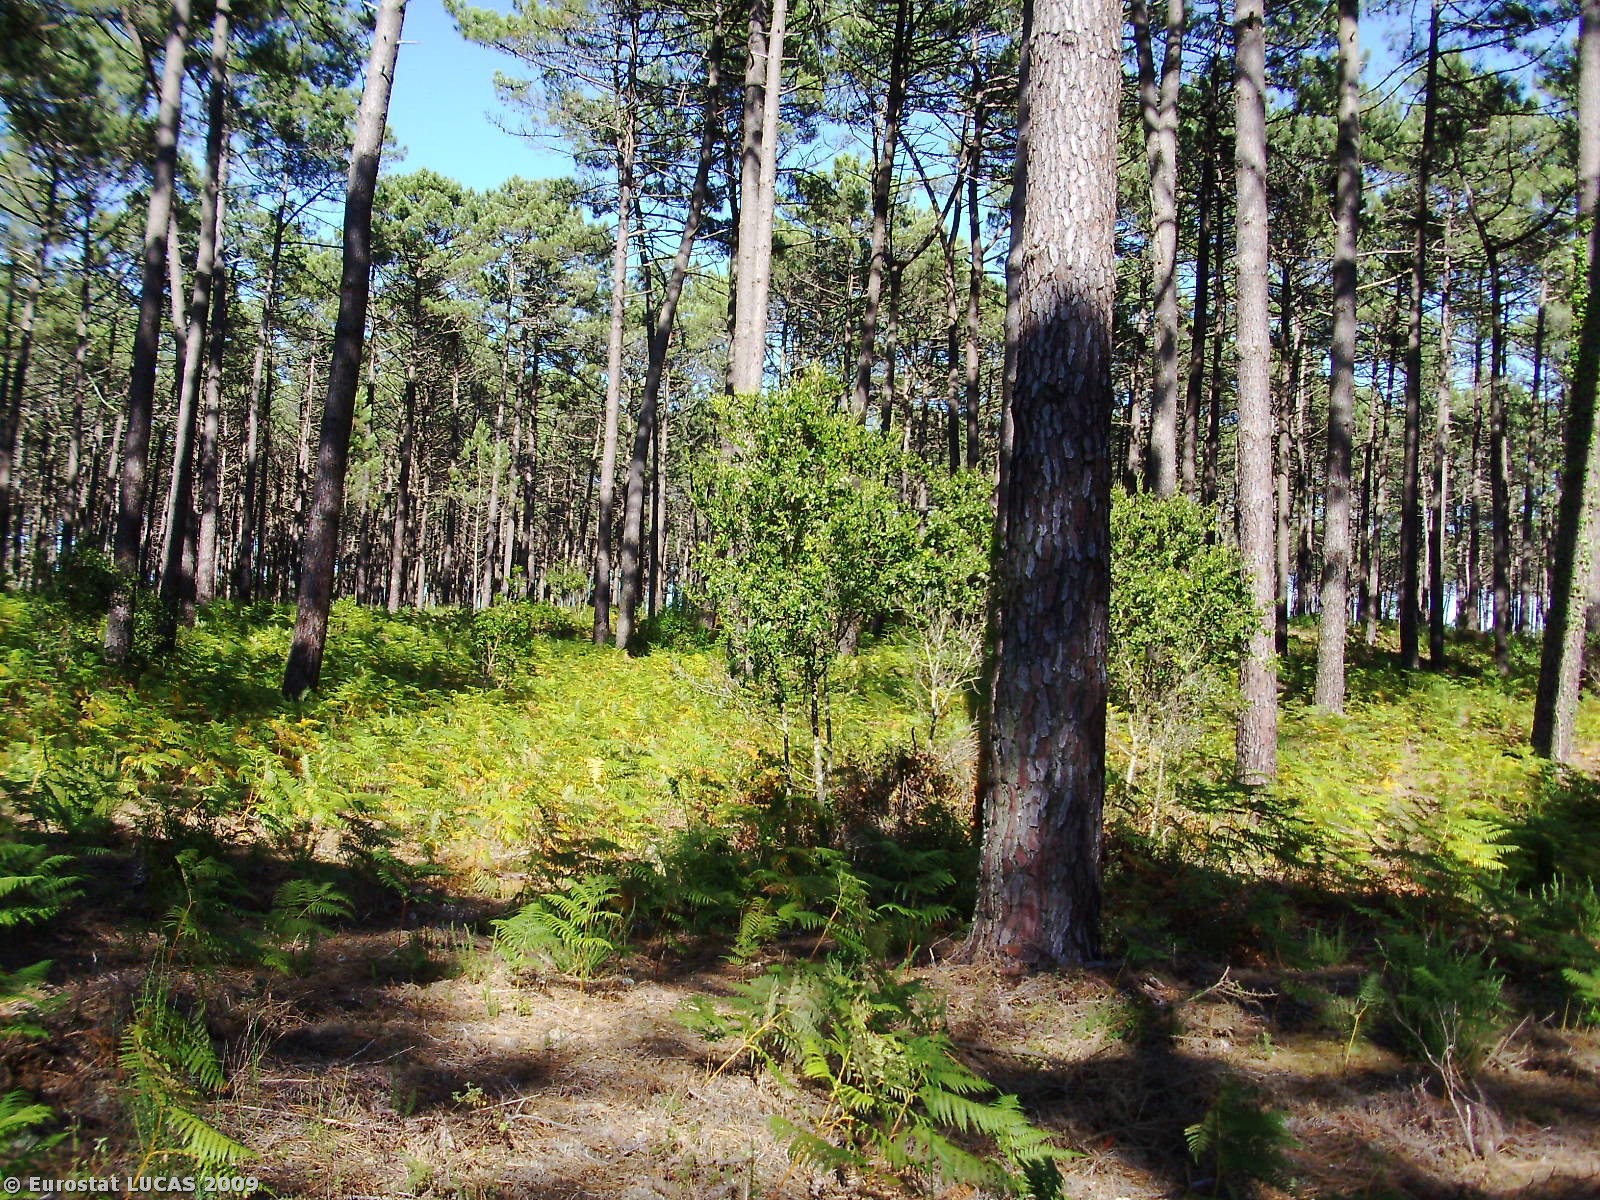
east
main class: Woodland
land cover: Coniferous woodland
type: coniferous forest of the mediterranean region
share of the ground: > 75 %
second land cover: Shrubland with sparse tree cover
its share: 10 - 25 %
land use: Forestry
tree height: > 5 m
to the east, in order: Coniferous woodland; Shrubland with sparse tree cover; Coniferous woodland
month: July
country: PT
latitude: 39.7639
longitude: -8.9905
